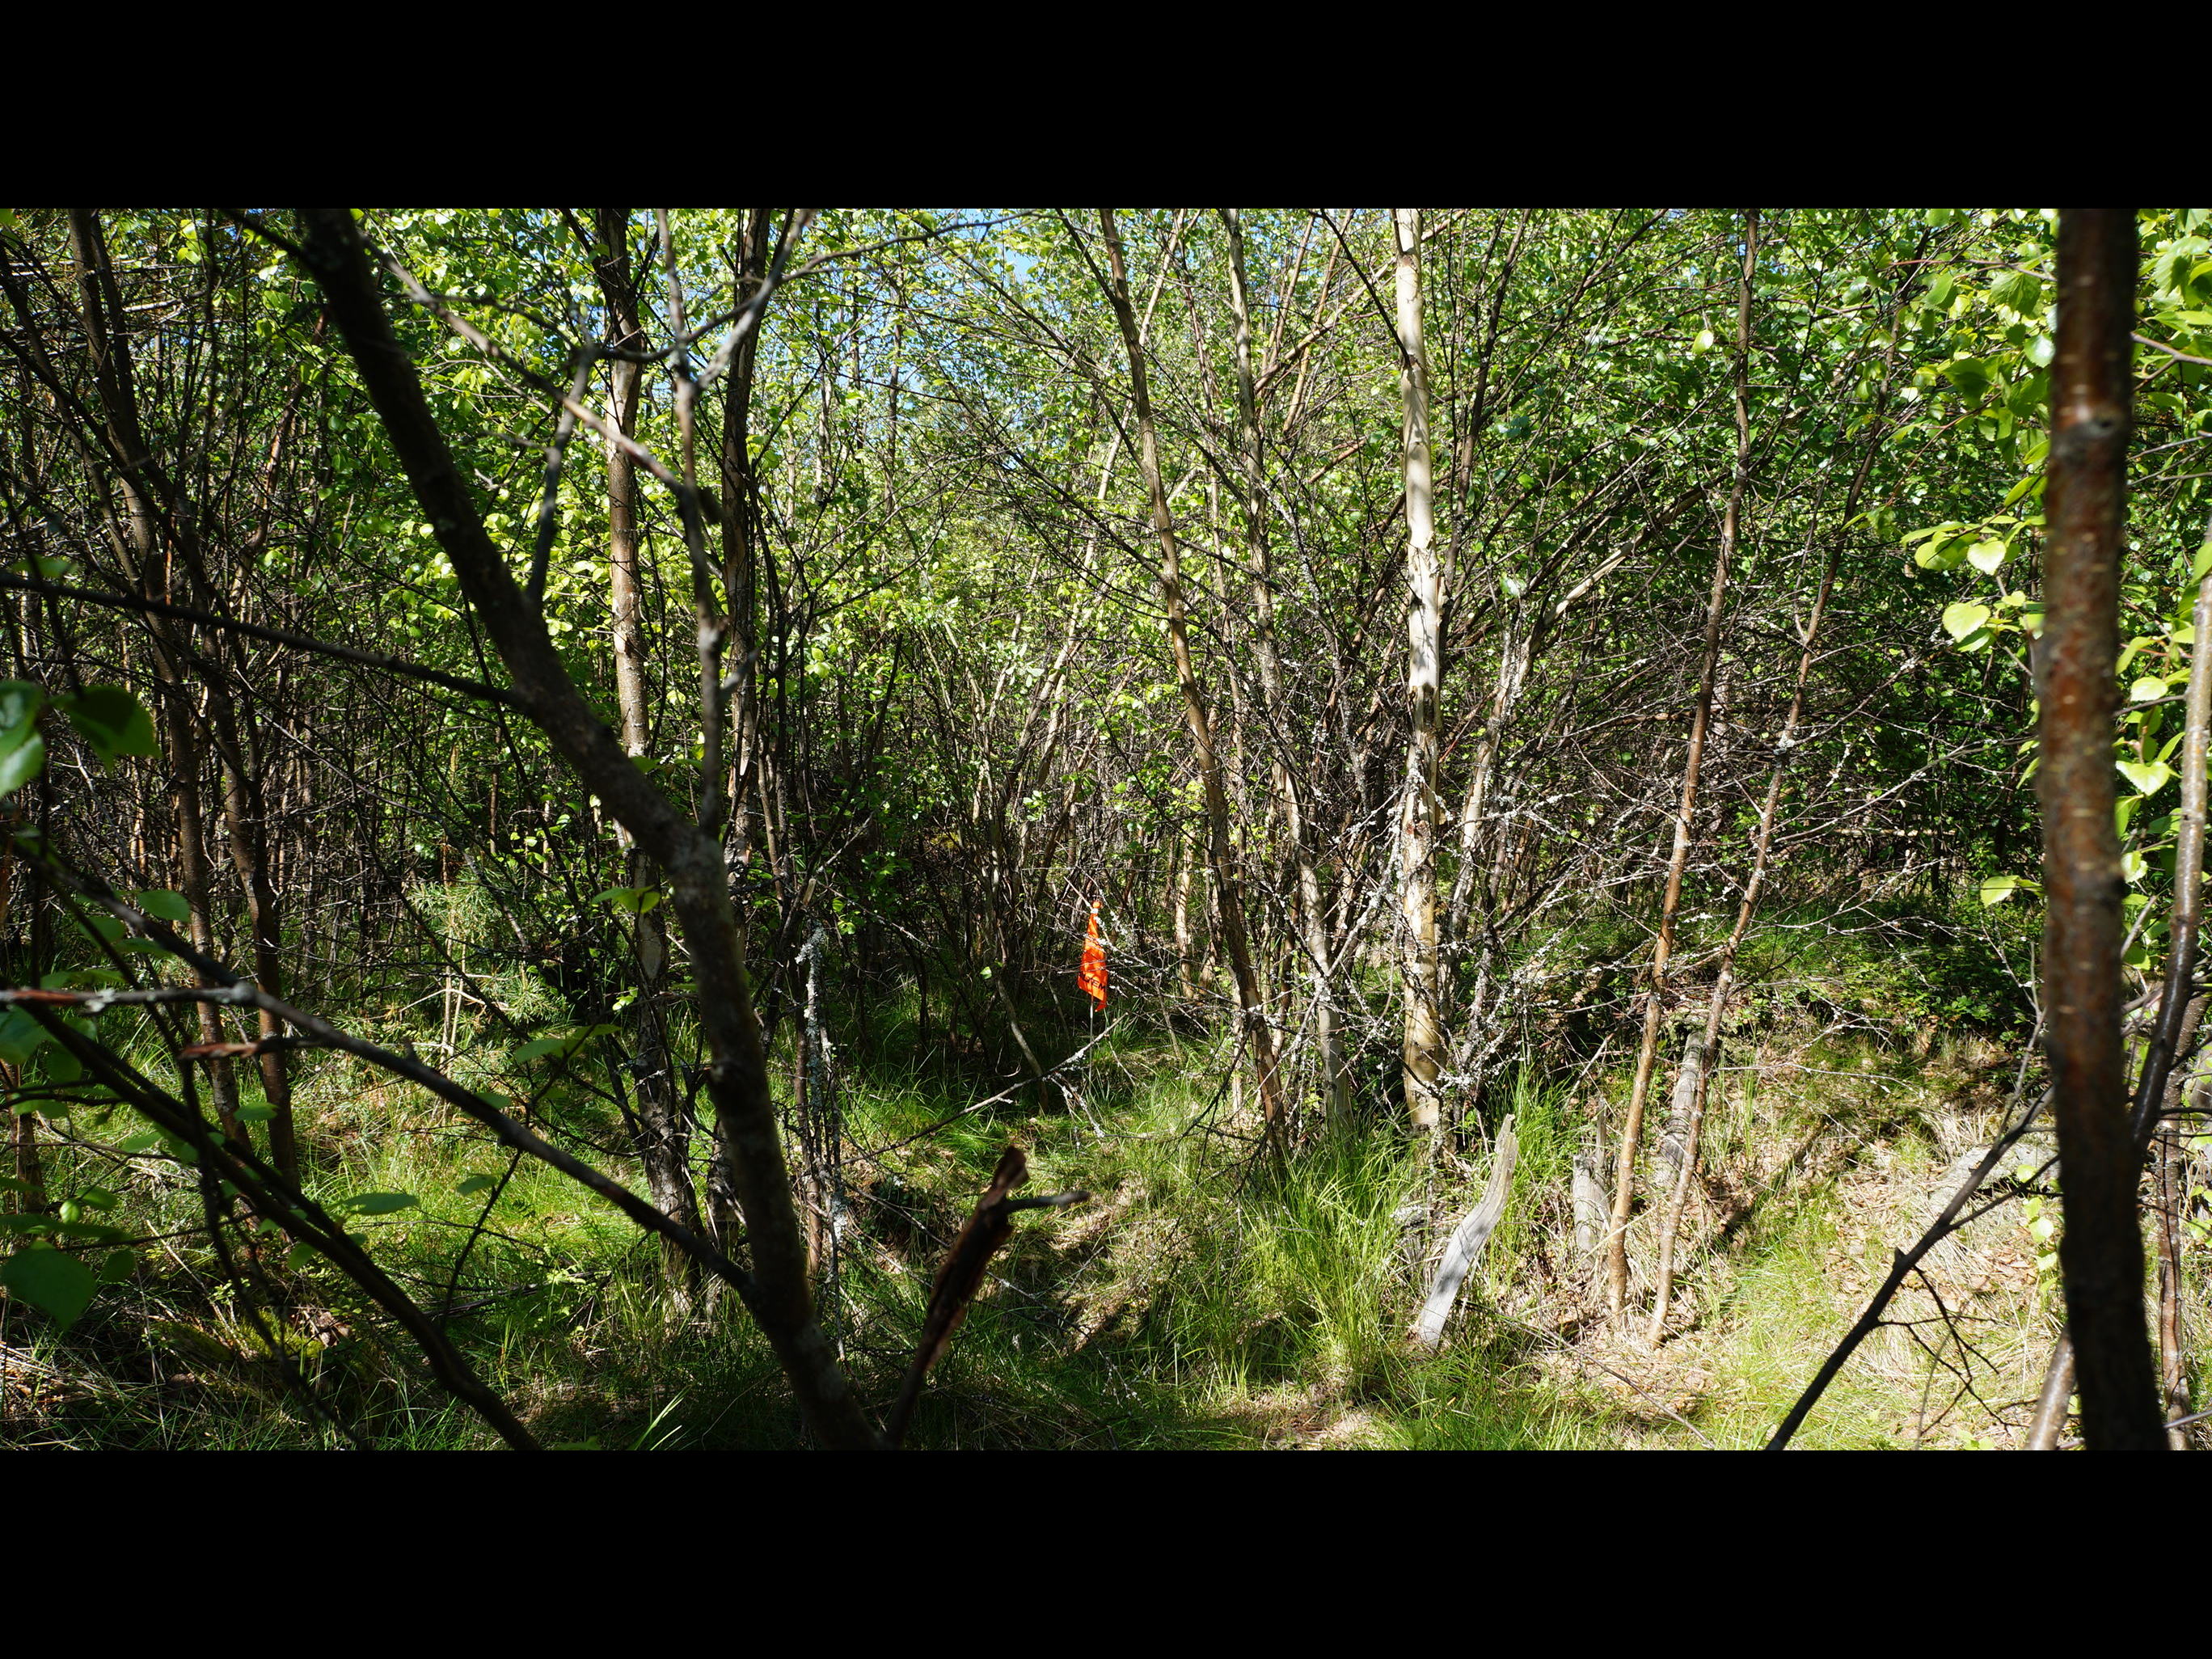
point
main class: Woodland
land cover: Broadleaved woodland
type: boreal forest
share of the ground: > 75 %
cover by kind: broadleaved forest trees 85 %, herbaceous plants 10 %, coniferous forest trees 5 %
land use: Forestry
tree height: < 5 m
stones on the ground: 10 - 25 %
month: June
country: FI
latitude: 64.2213
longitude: 23.9317
